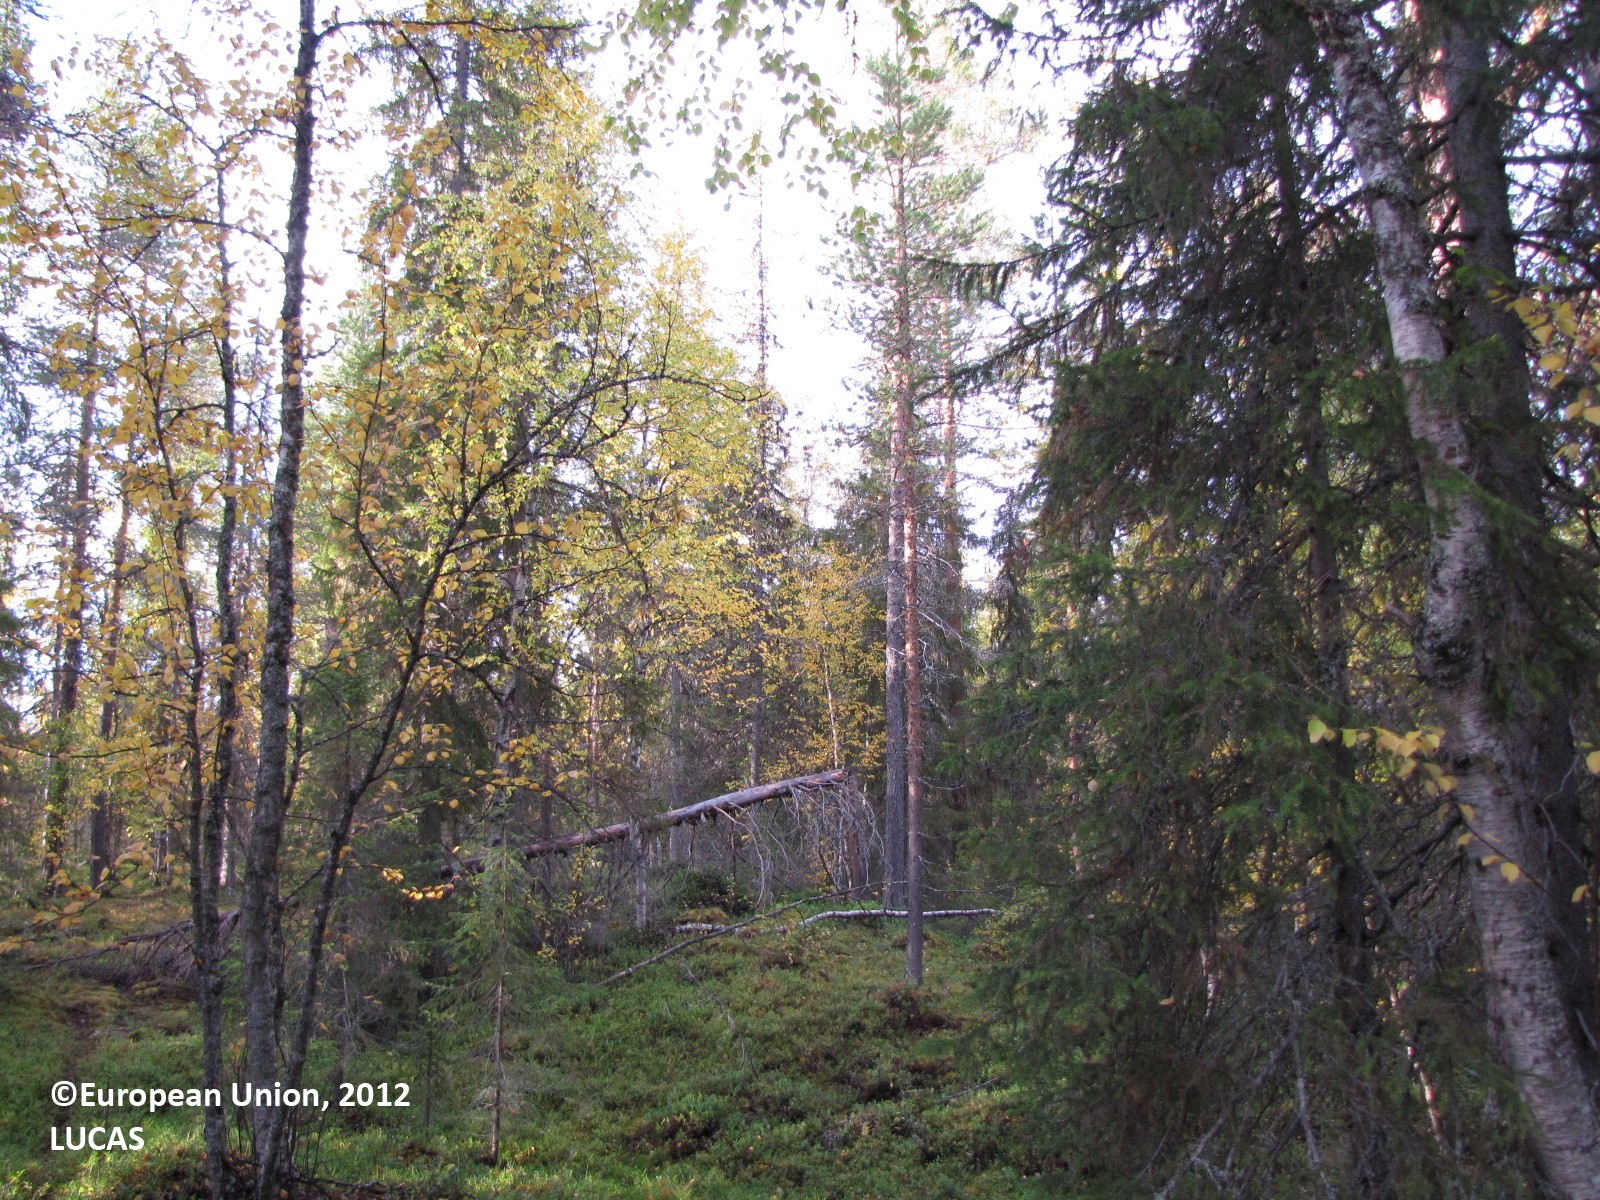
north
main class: Woodland
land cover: Other mixed woodland
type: boreal forest
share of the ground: 25 - 50 %
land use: Forestry
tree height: > 5 m
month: September
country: FI
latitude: 67.3314
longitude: 25.3243
